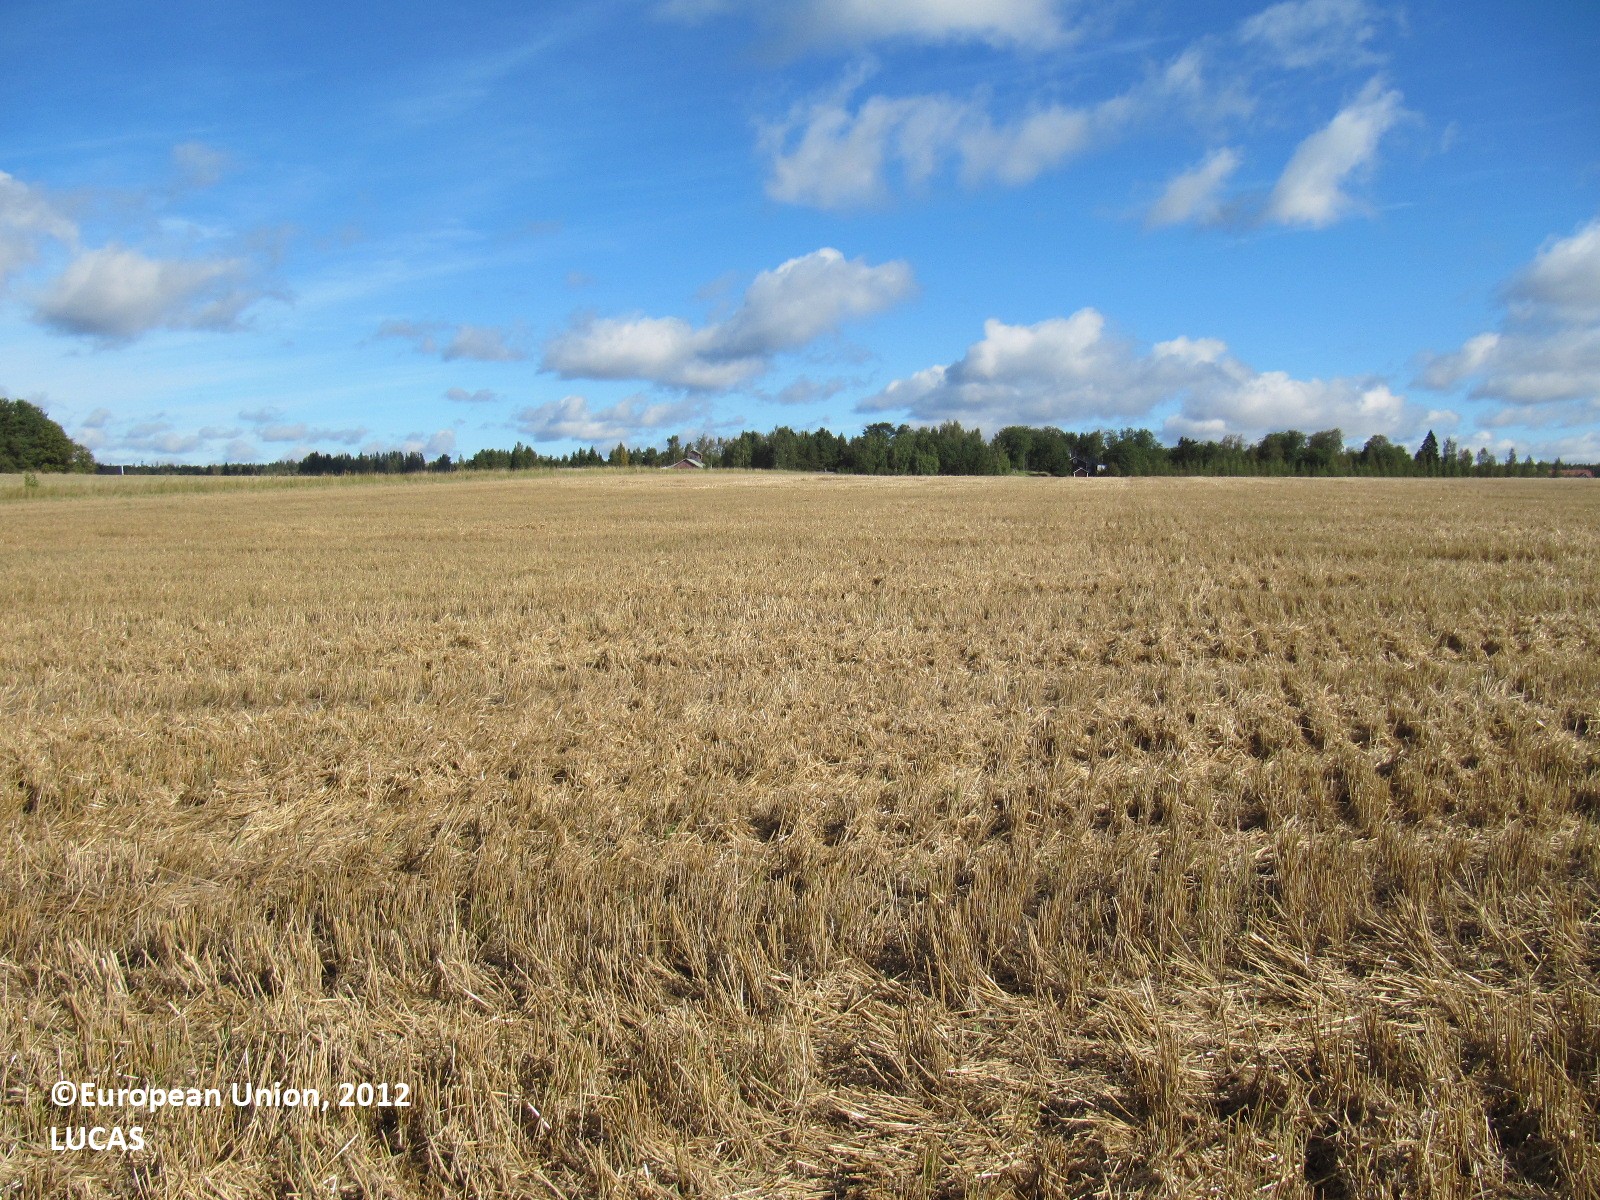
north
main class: Cropland
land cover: Barley
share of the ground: 50 - 75 %
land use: Agriculture (excluding fallow land and kitchen gardens)
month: September
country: FI
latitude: 60.7925
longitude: 23.2898
